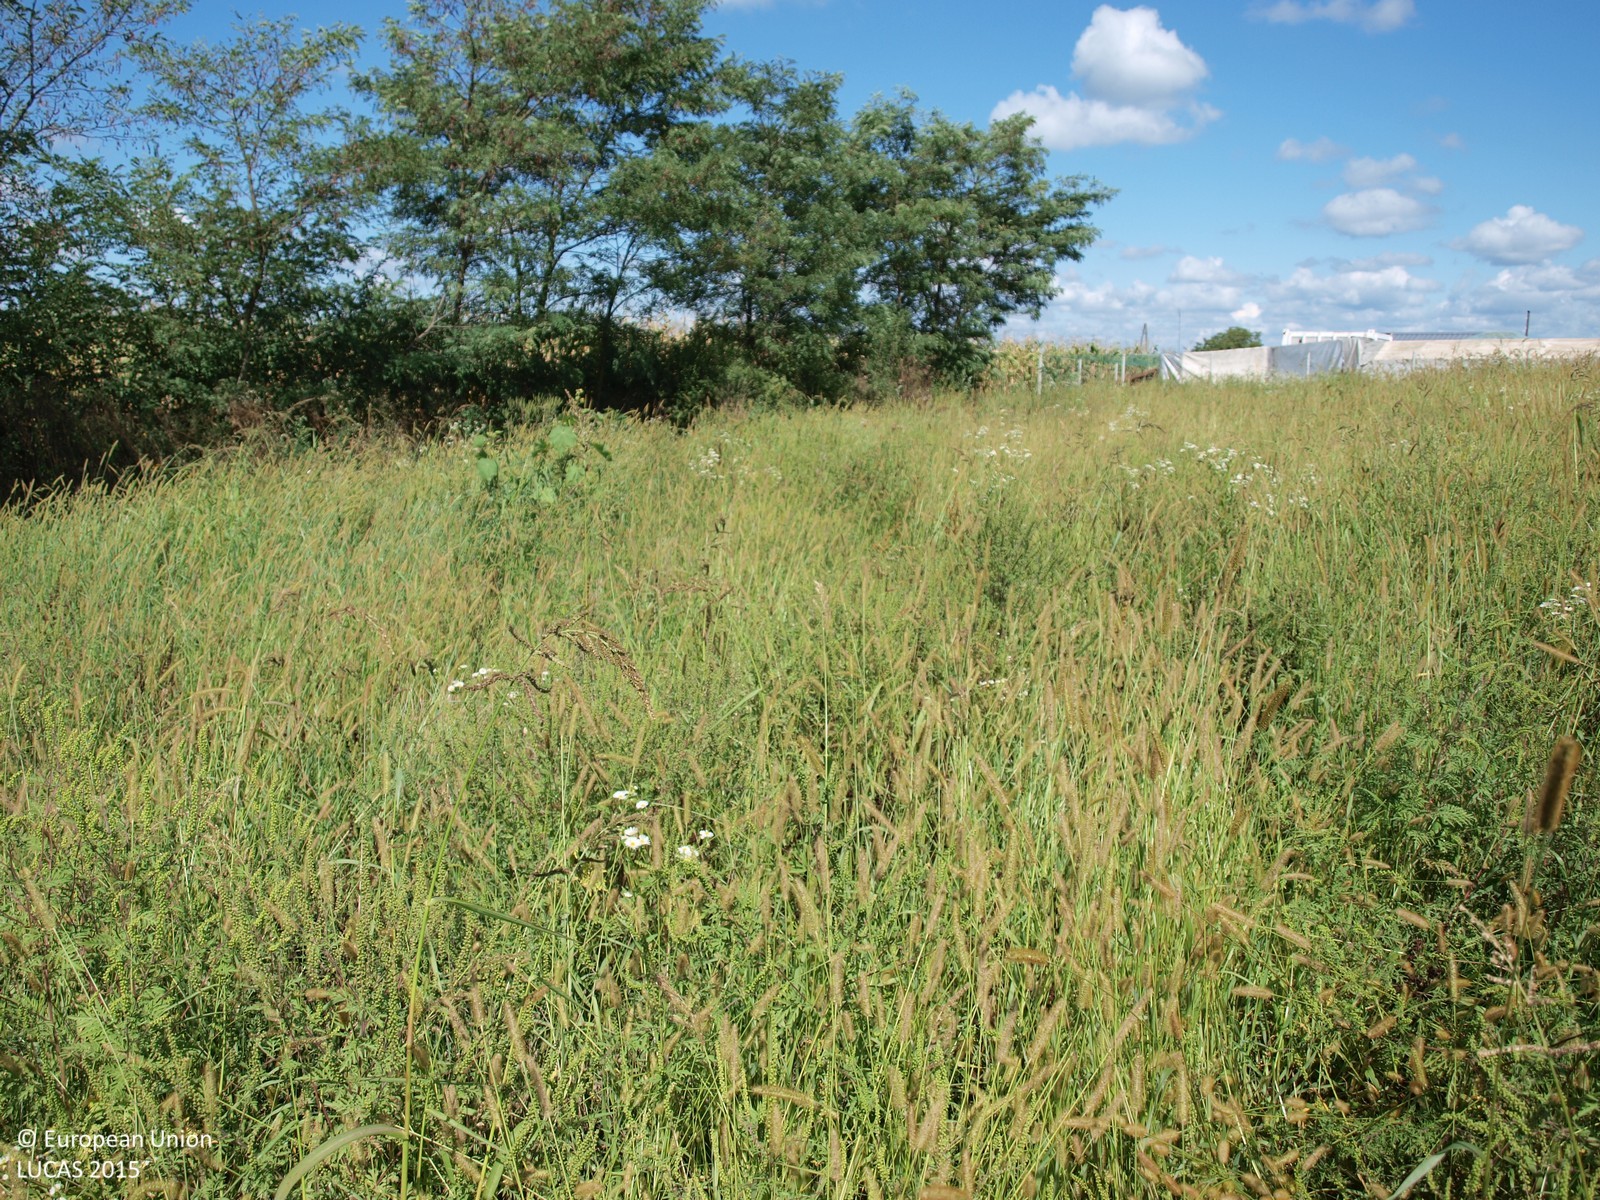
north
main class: Grassland
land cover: Grassland without tree/shrub cover
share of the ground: > 75 %
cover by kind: herbaceous plants 100 %
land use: Agriculture (excluding fallow land and kitchen gardens)
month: September
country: HR
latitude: 45.7432
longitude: 16.4124
